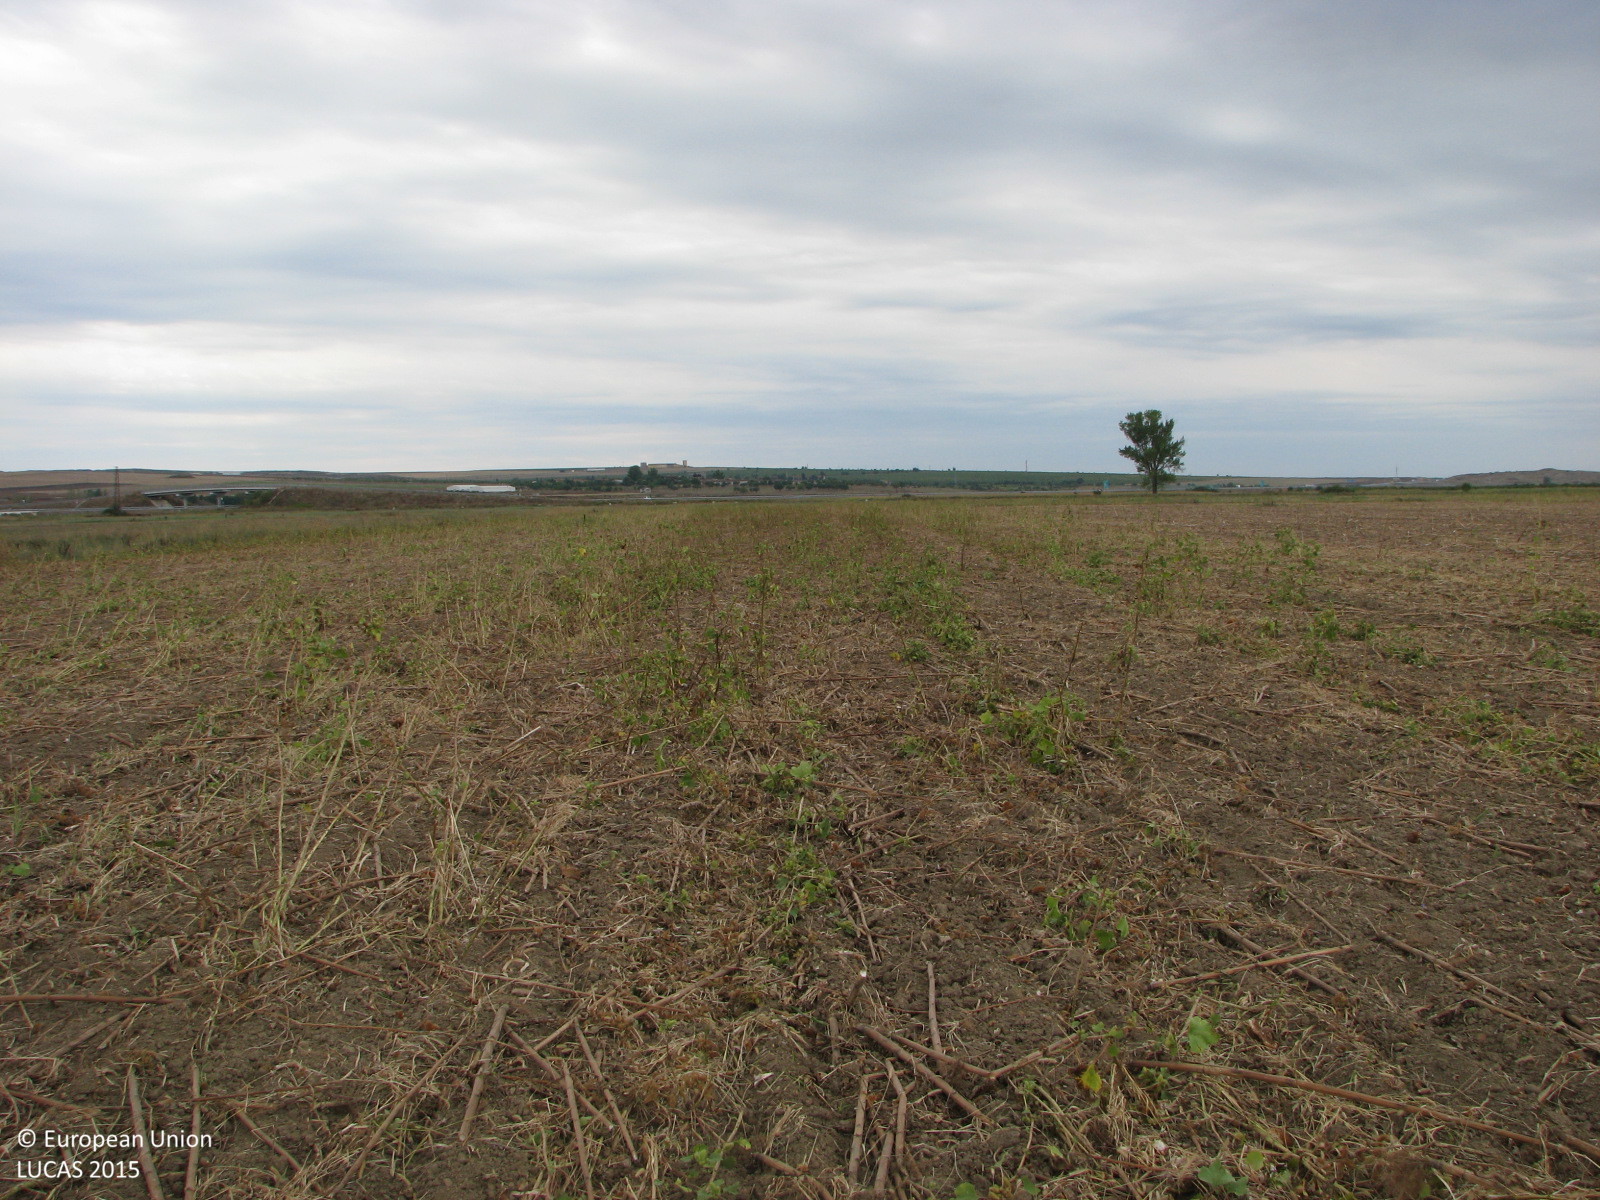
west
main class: Cropland
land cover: Sunflower
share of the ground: < 10 %
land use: Agriculture (excluding fallow land and kitchen gardens)
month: September
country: BG
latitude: 42.5493
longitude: 26.4469
